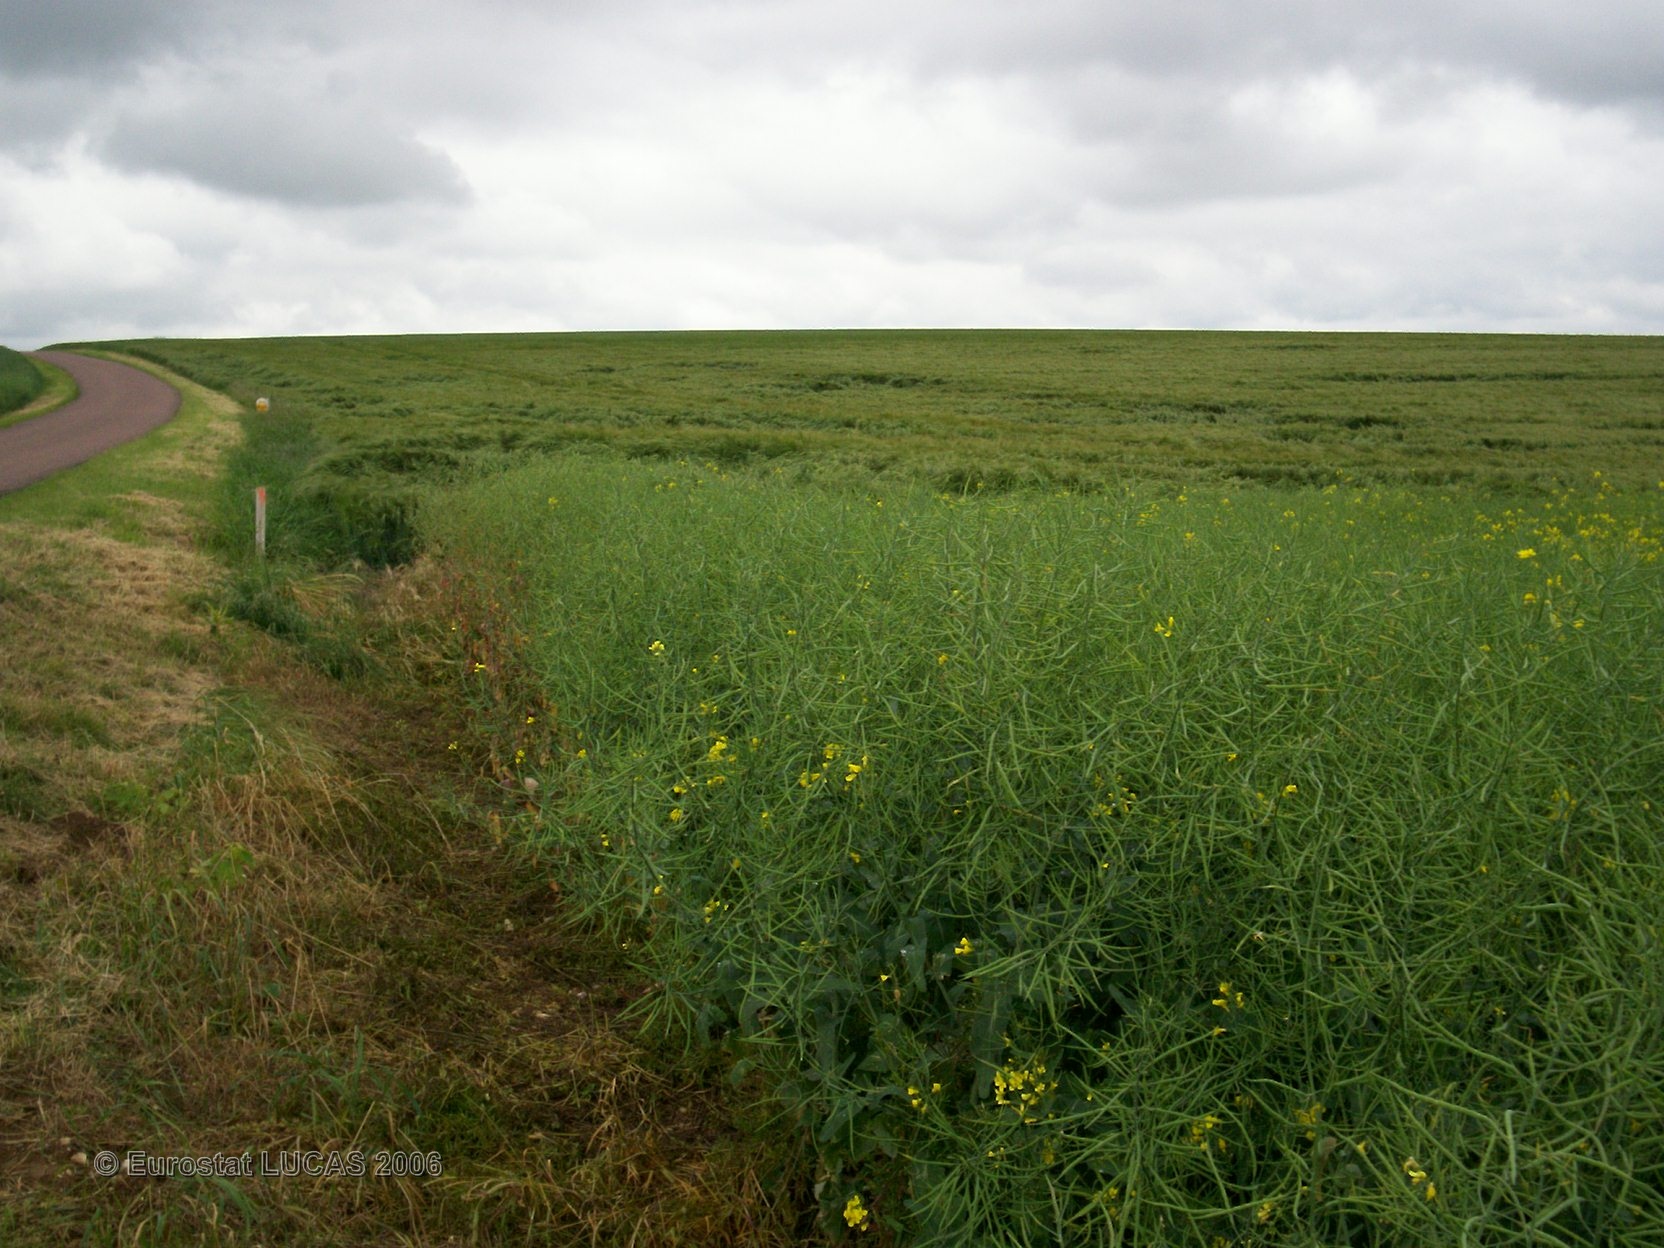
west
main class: Cropland
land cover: Rape and turnip rape
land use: Agriculture (excluding fallow land and kitchen gardens)
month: May
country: FR
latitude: 48.1969
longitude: 4.5491
